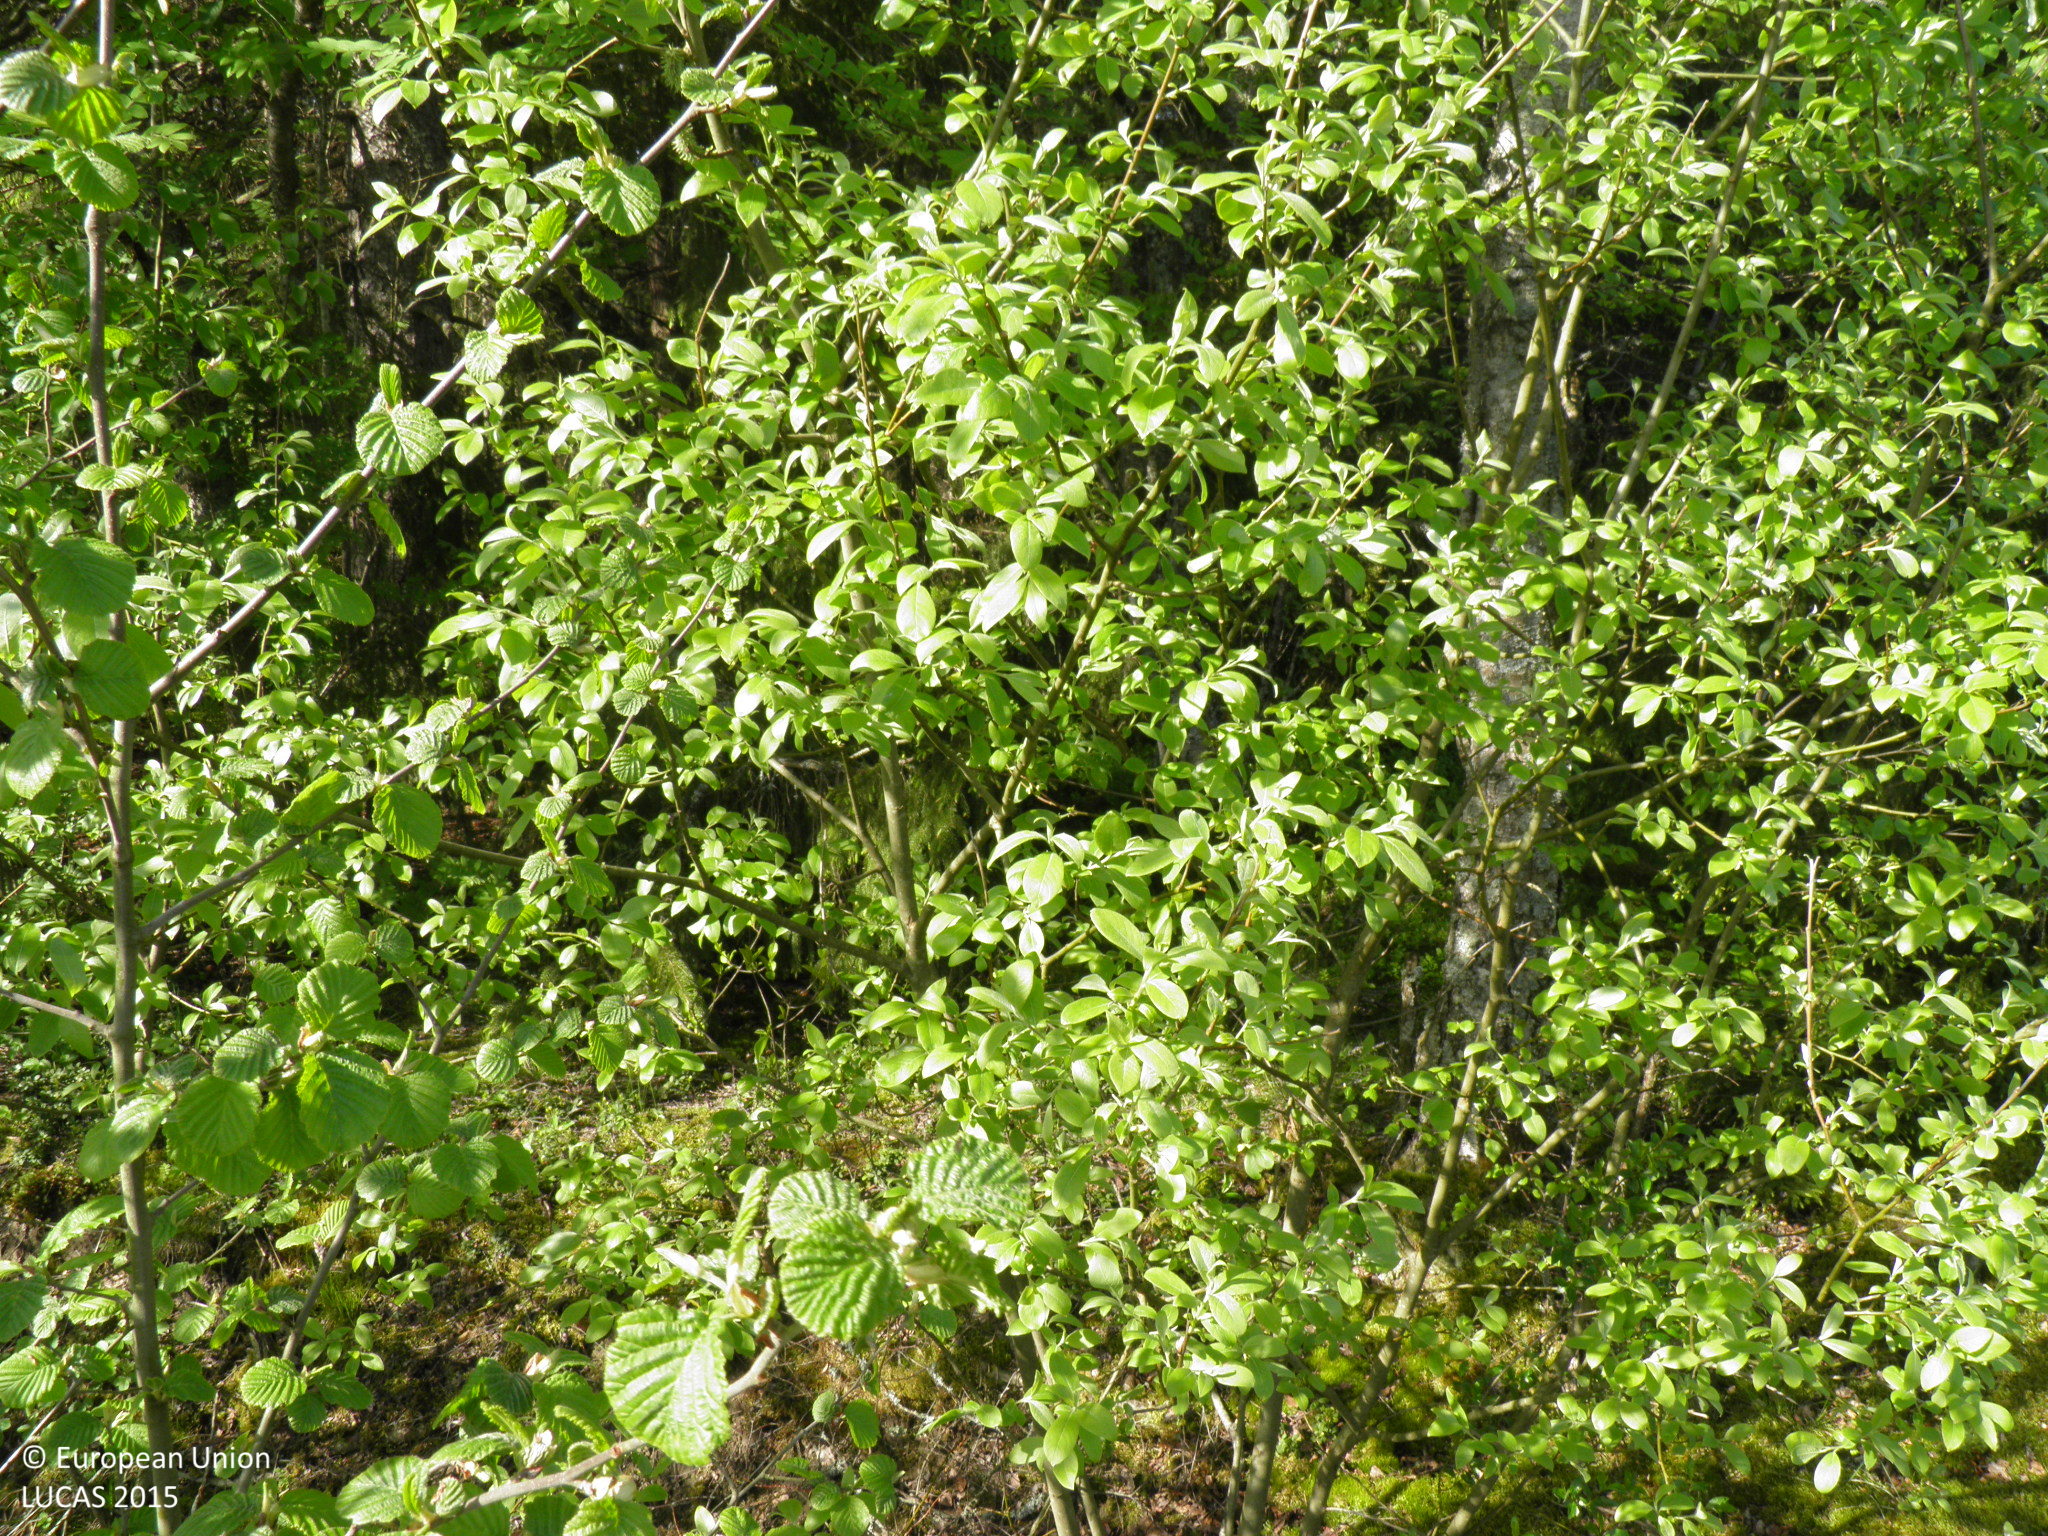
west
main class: Cropland
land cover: Common wheat
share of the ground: < 10 %
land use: Agriculture (excluding fallow land and kitchen gardens)
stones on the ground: < 10 %
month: June
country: FI
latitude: 60.5272
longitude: 22.5891
